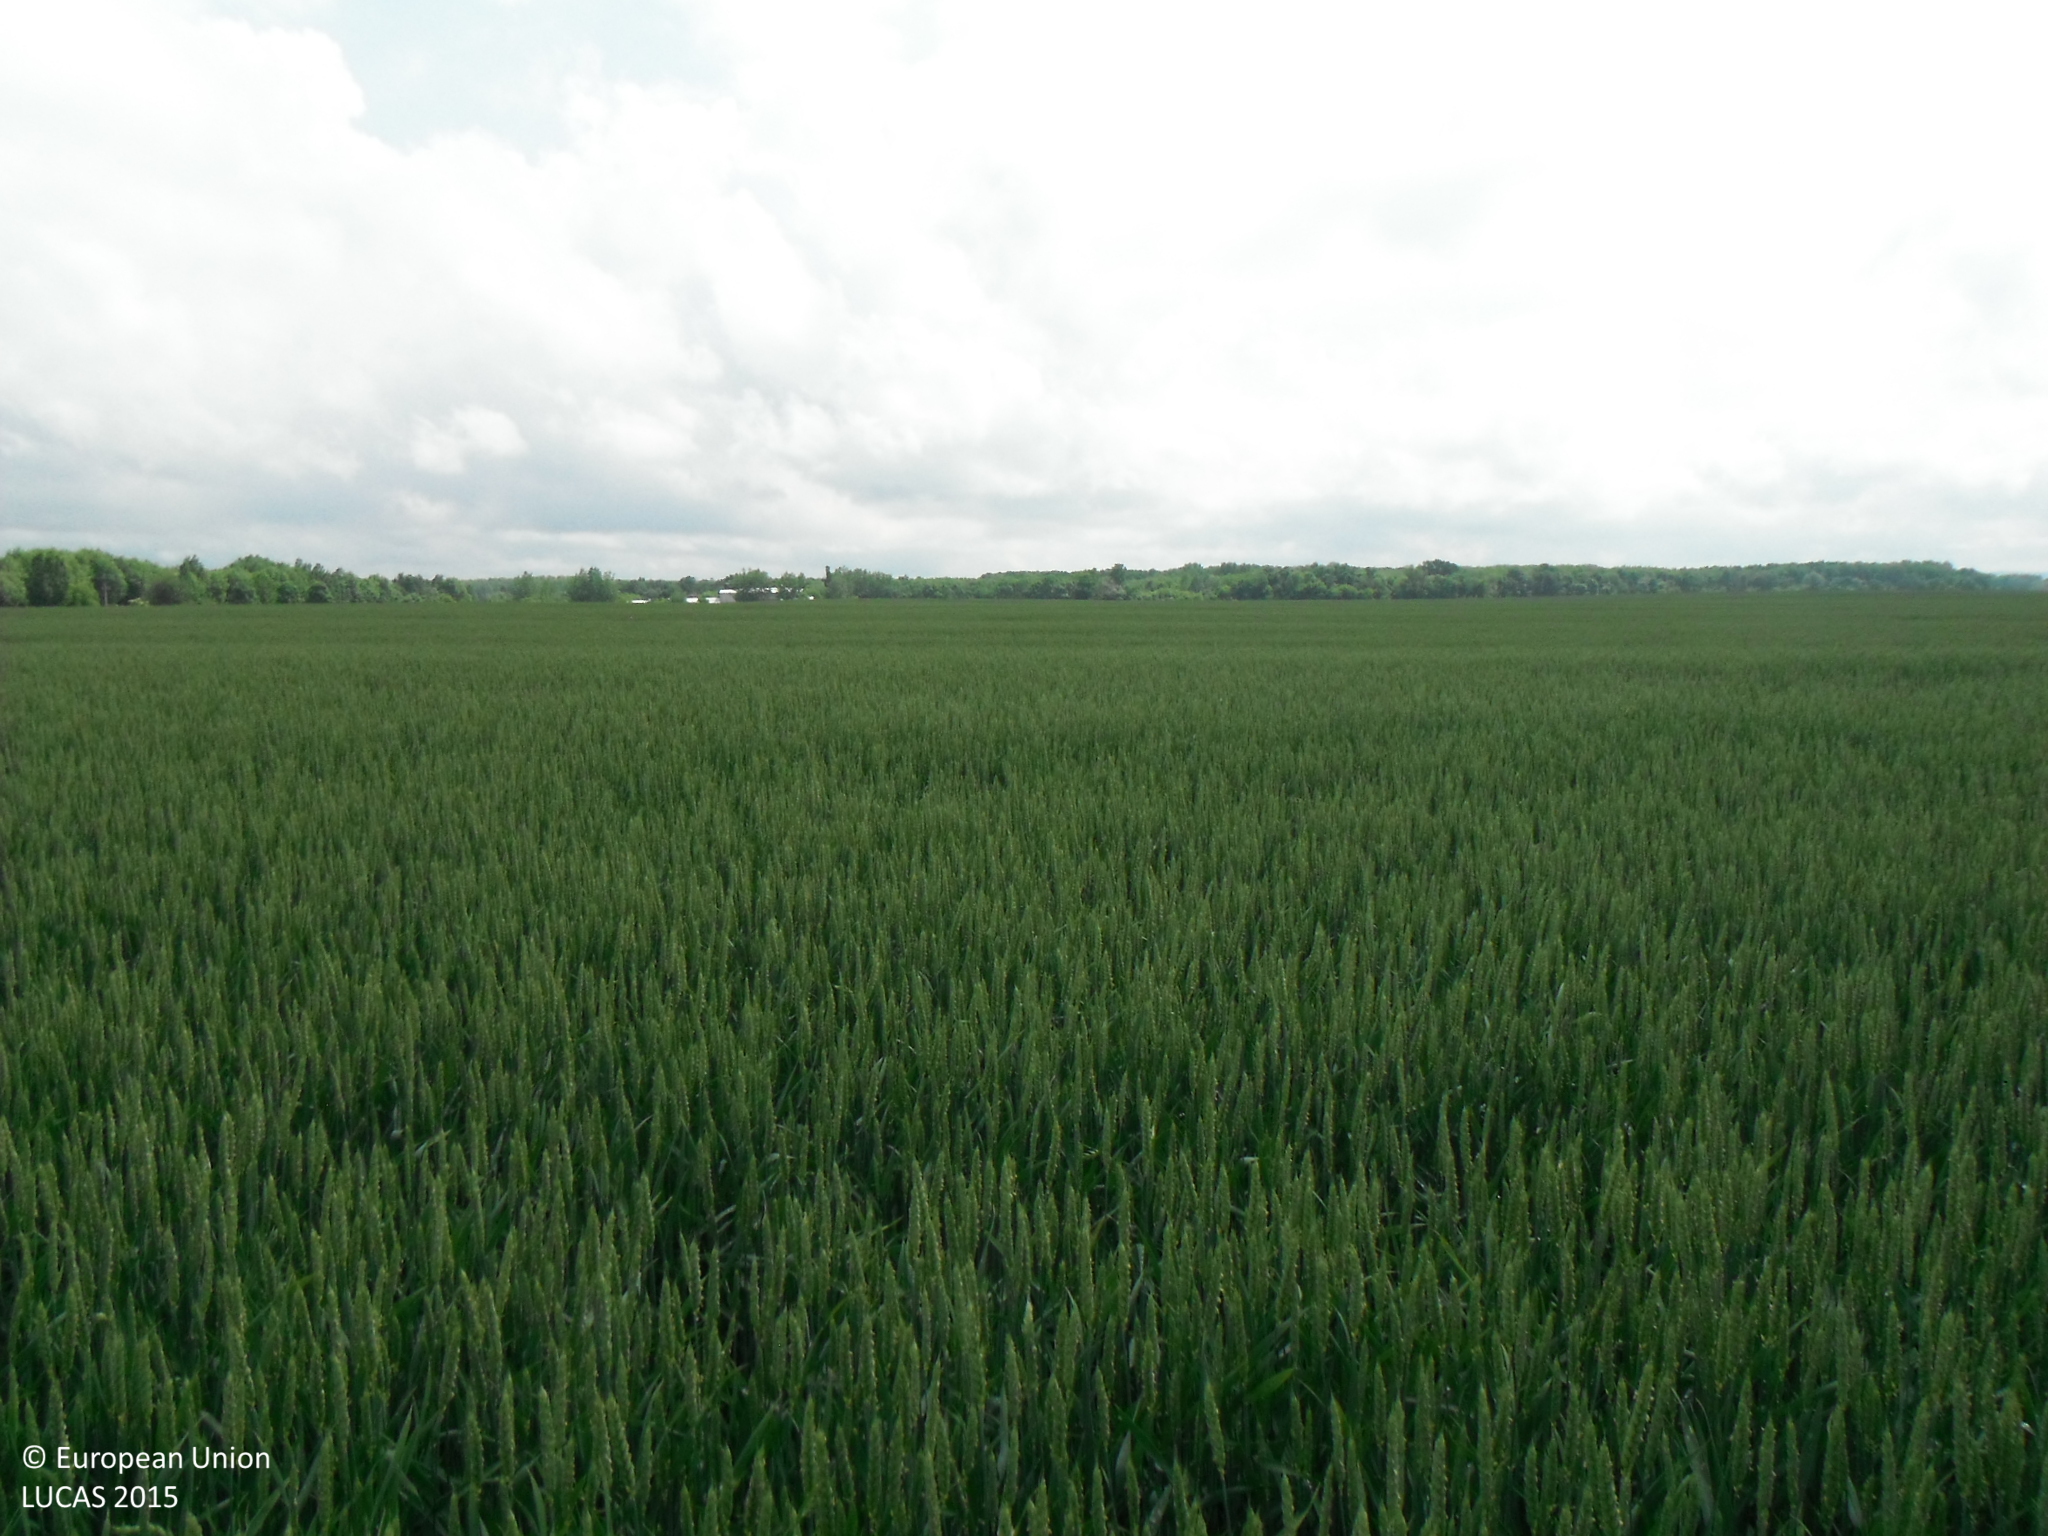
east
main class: Cropland
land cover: Common wheat
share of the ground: > 75 %
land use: Agriculture (excluding fallow land and kitchen gardens)
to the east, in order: Common wheat
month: May
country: SK
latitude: 48.1528
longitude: 18.2003
